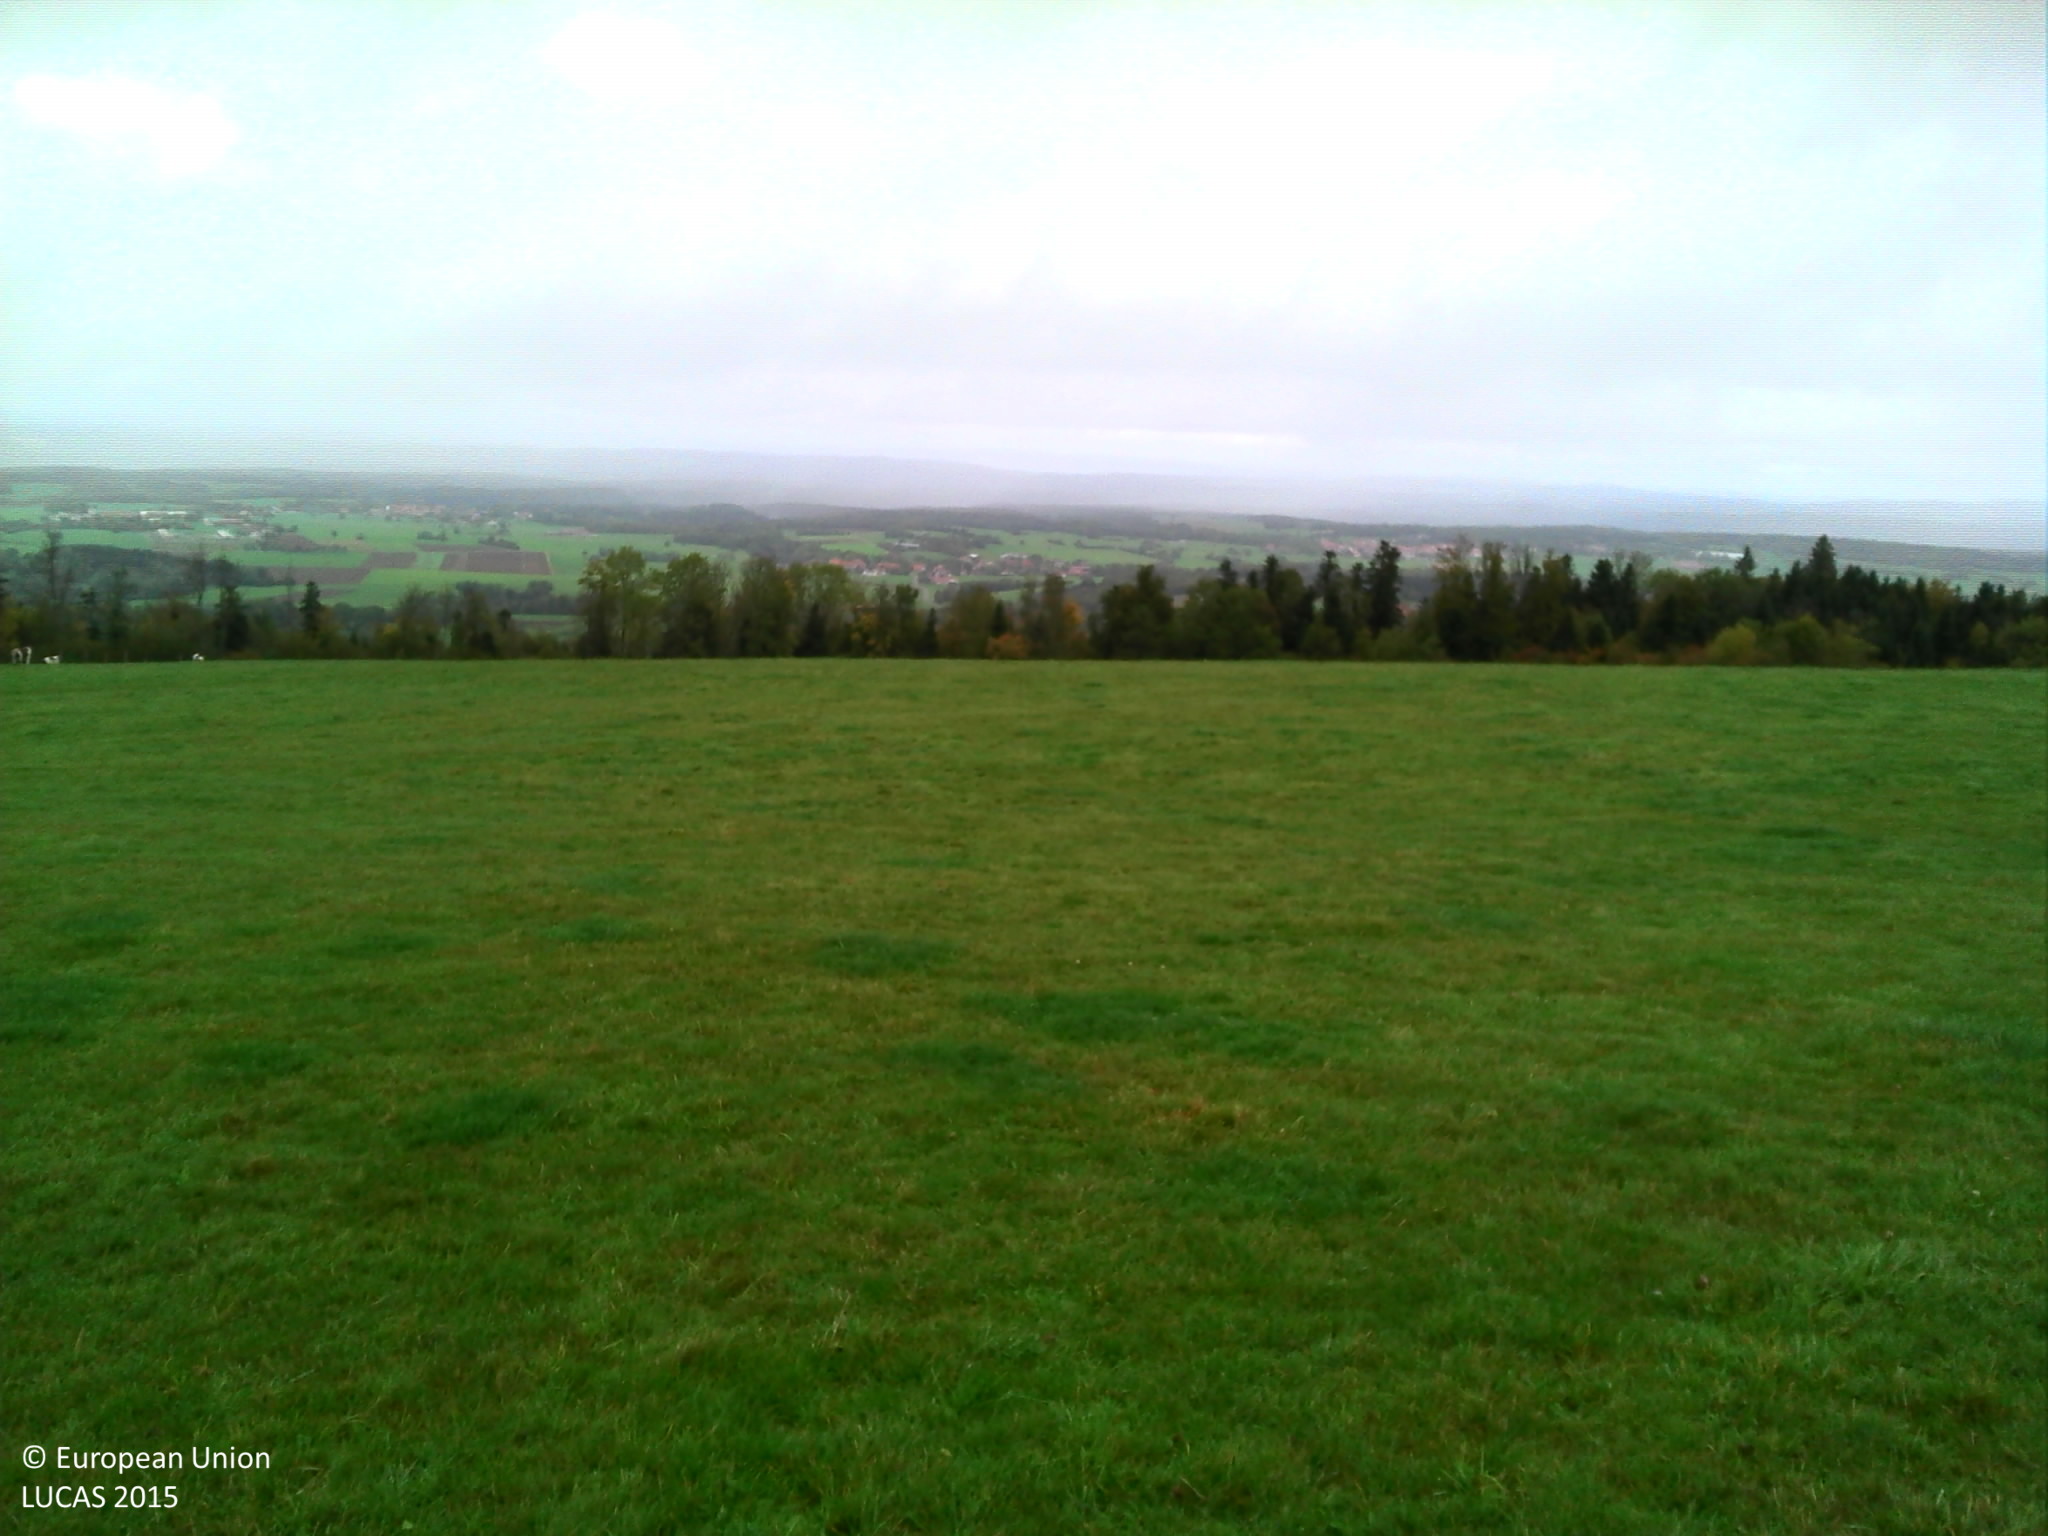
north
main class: Grassland
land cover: Grassland without tree/shrub cover
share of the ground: > 75 %
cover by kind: herbaceous plants 100 %
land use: Agriculture (excluding fallow land and kitchen gardens)
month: October
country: FR
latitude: 47.0030
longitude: 6.1487
